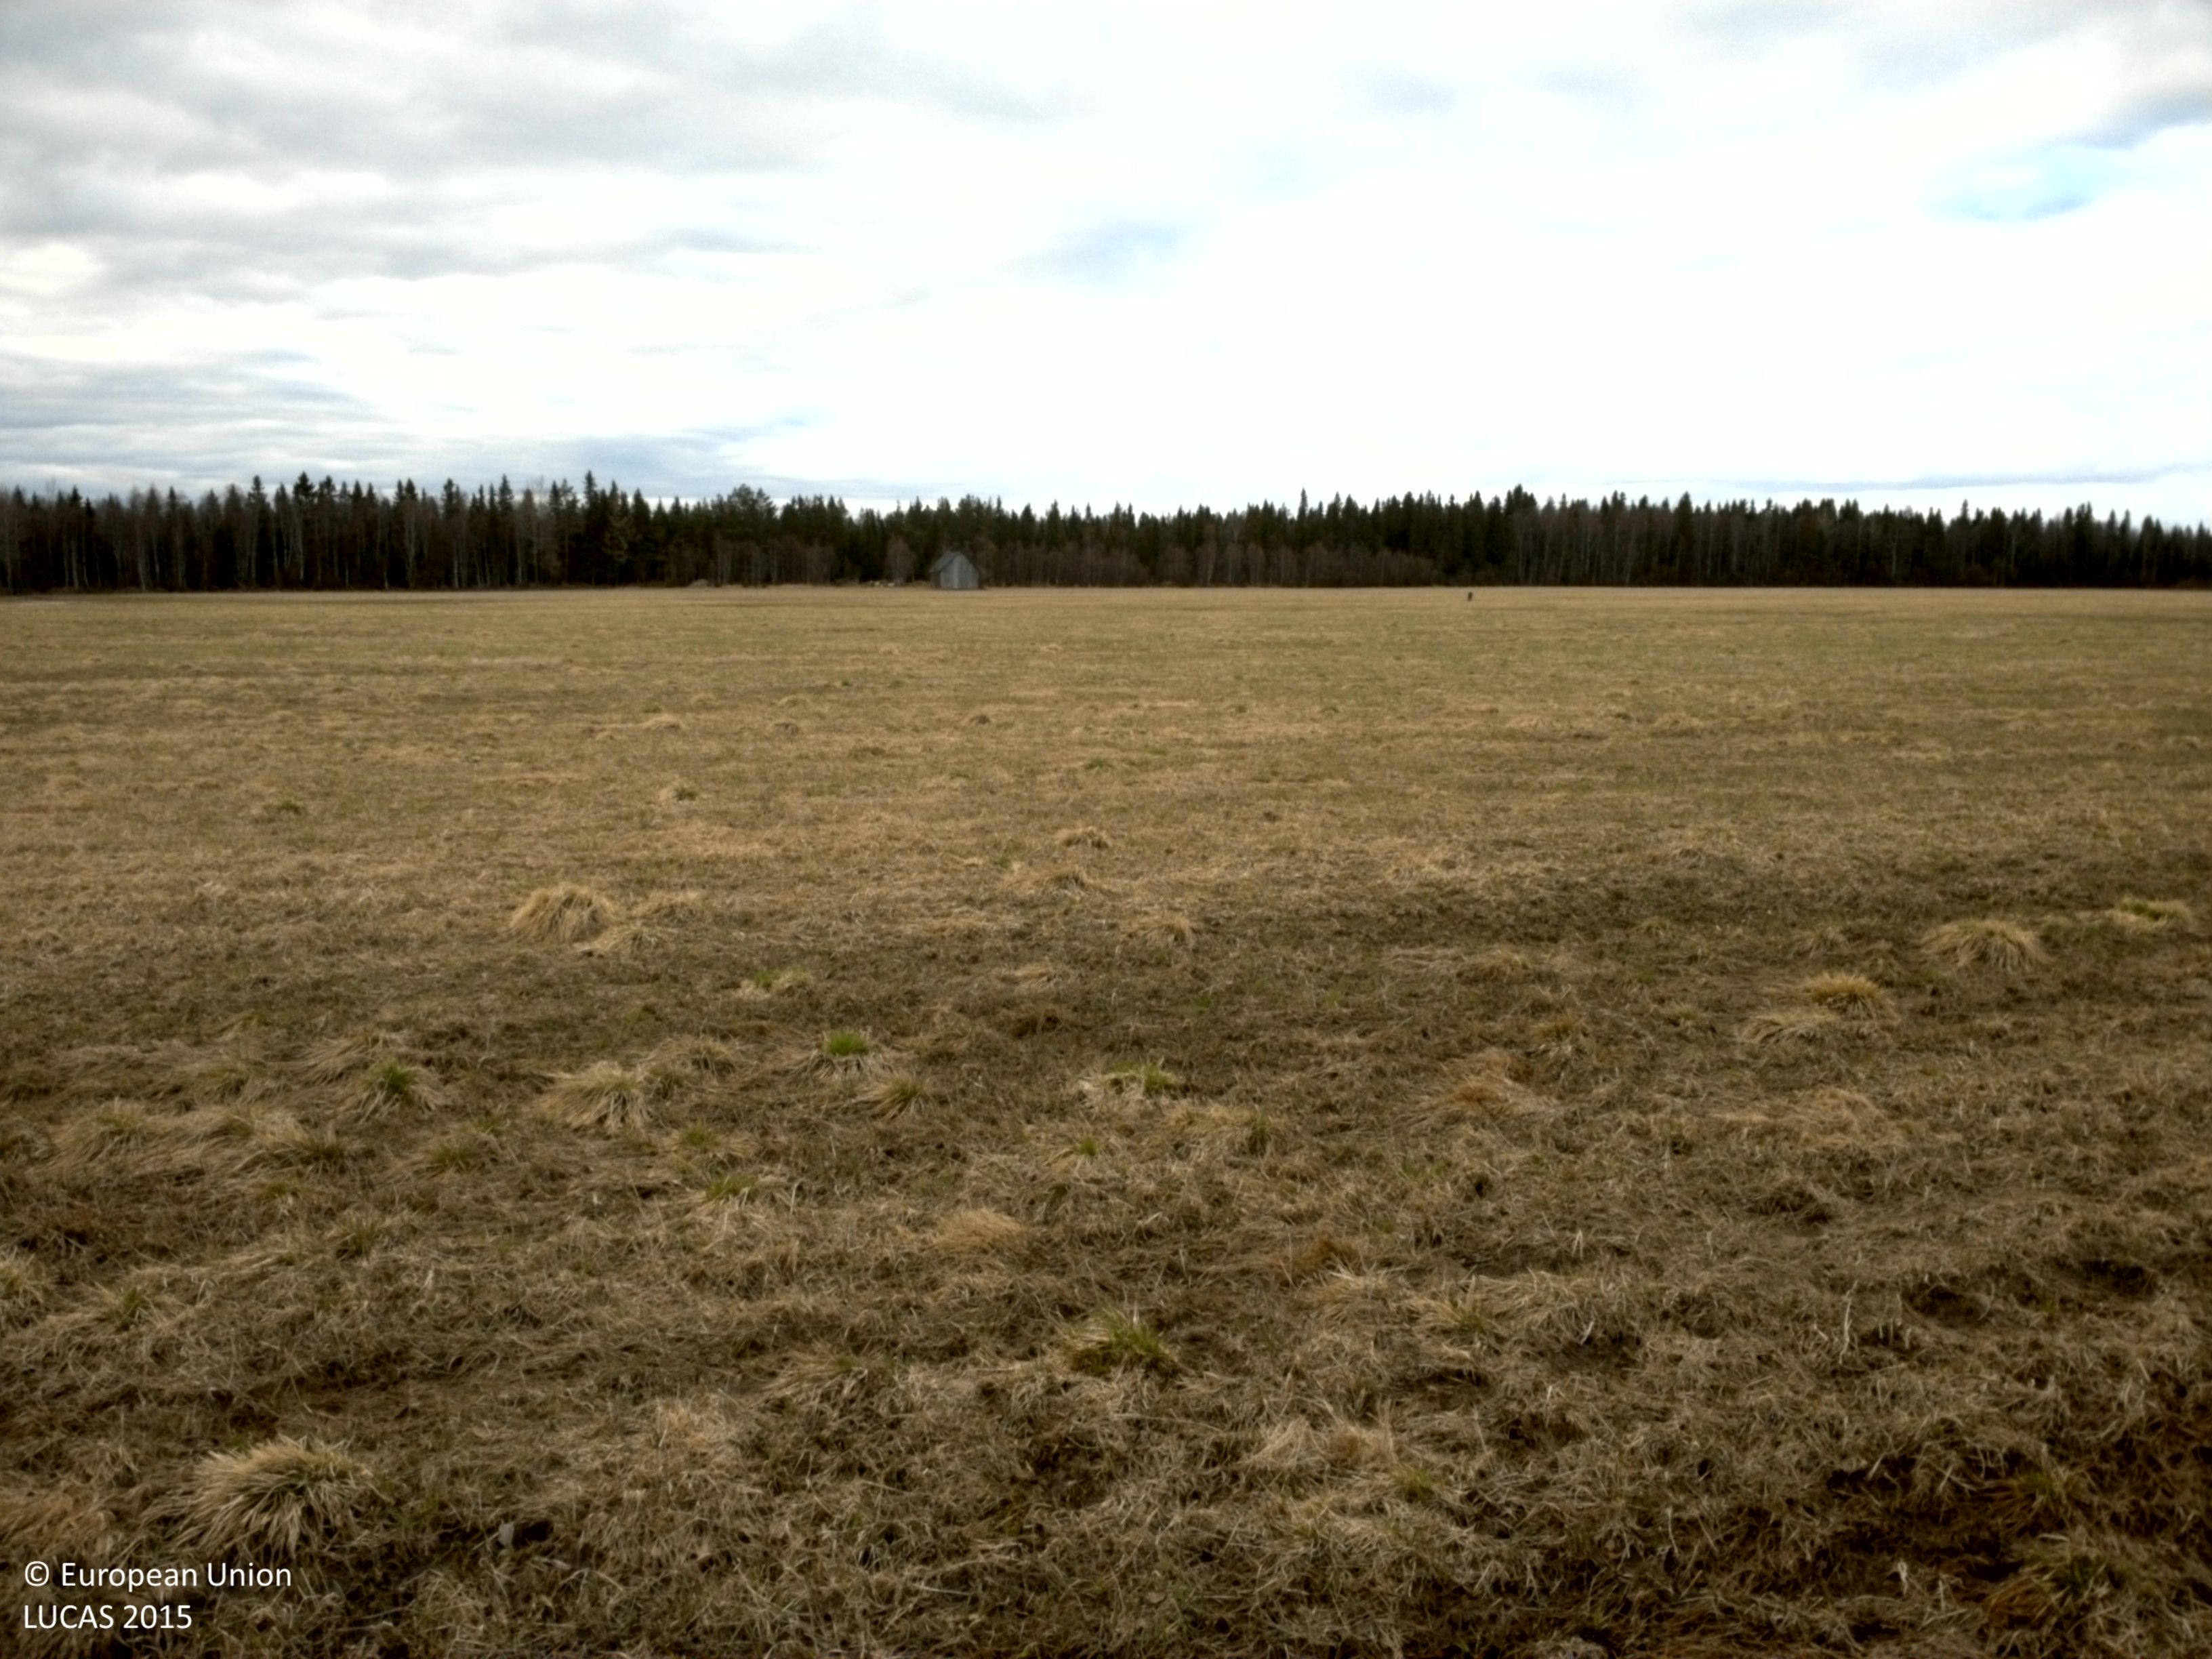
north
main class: Cropland
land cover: Temporary grasslands
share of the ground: > 75 %
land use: Agriculture (excluding fallow land and kitchen gardens)
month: May
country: SE
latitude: 65.8303
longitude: 24.0762
